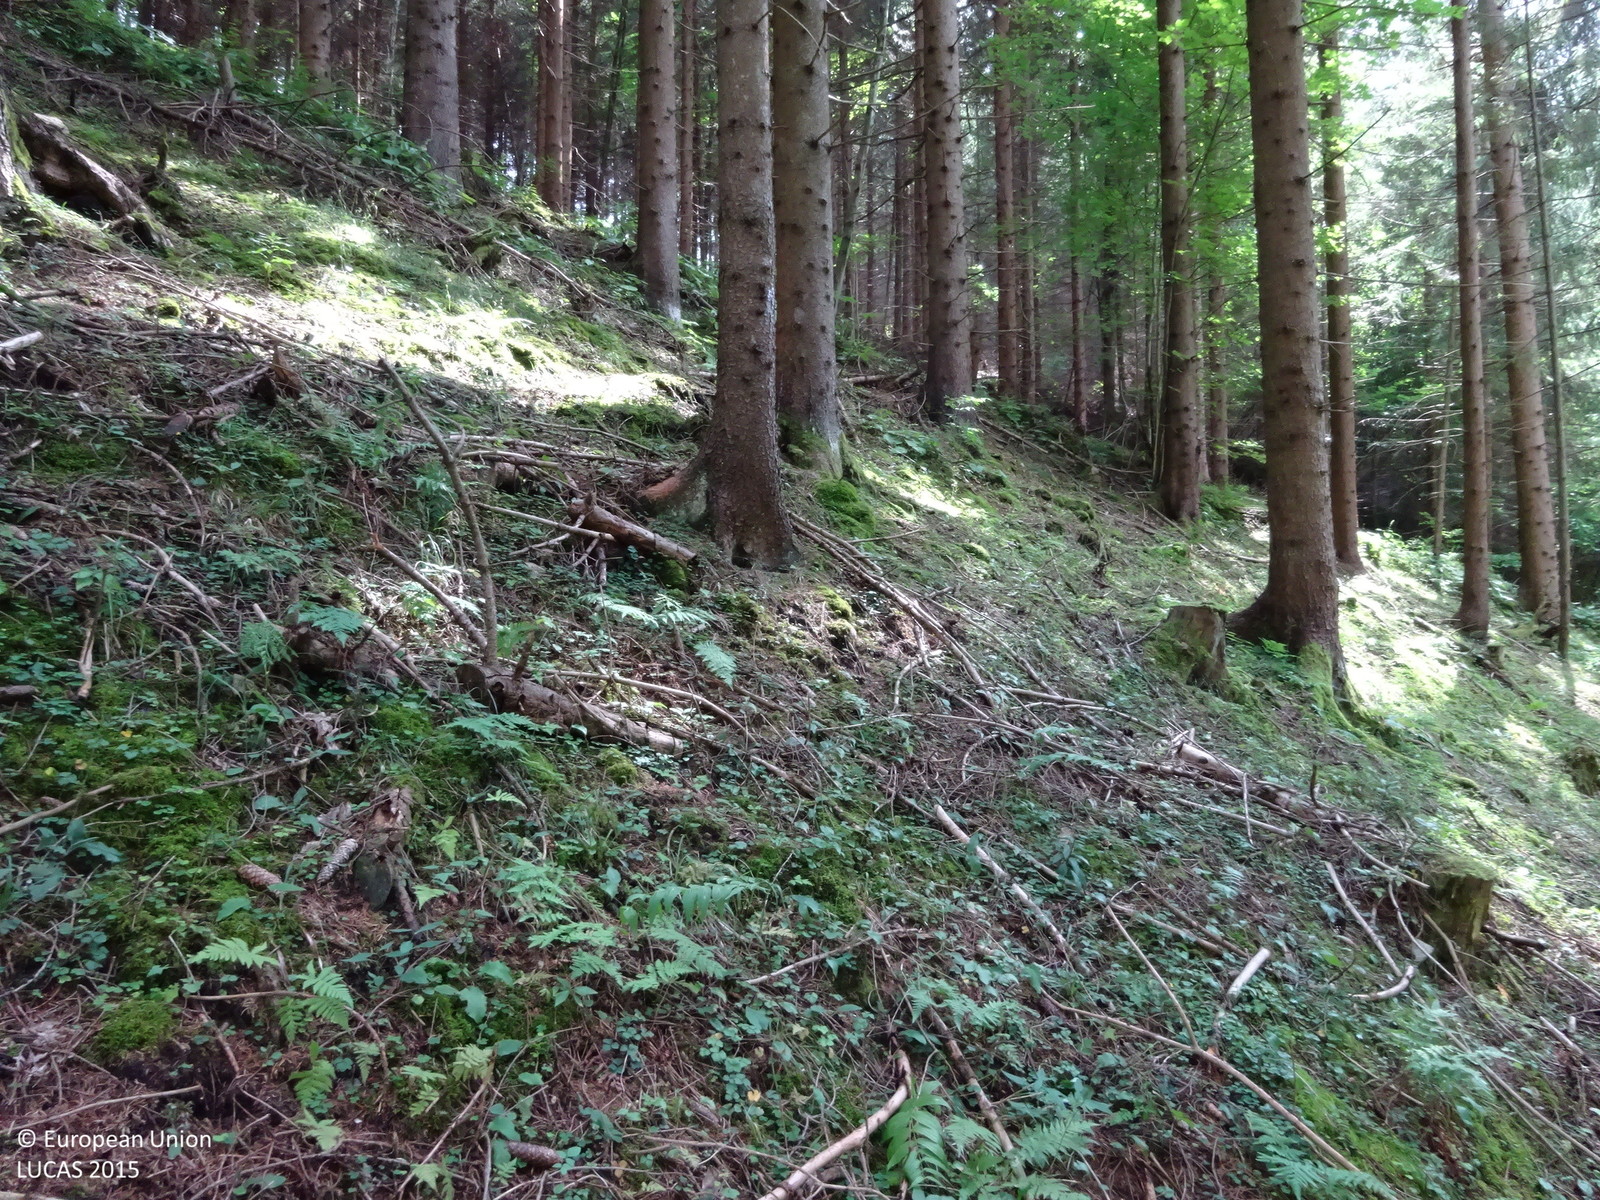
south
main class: Woodland
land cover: Spruce dominated coniferous woodland
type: alpine coniferous forest
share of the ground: > 75 %
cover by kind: coniferous forest trees 100 %
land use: Forestry
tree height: > 5 m
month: July
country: AT
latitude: 47.3829
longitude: 15.4977
